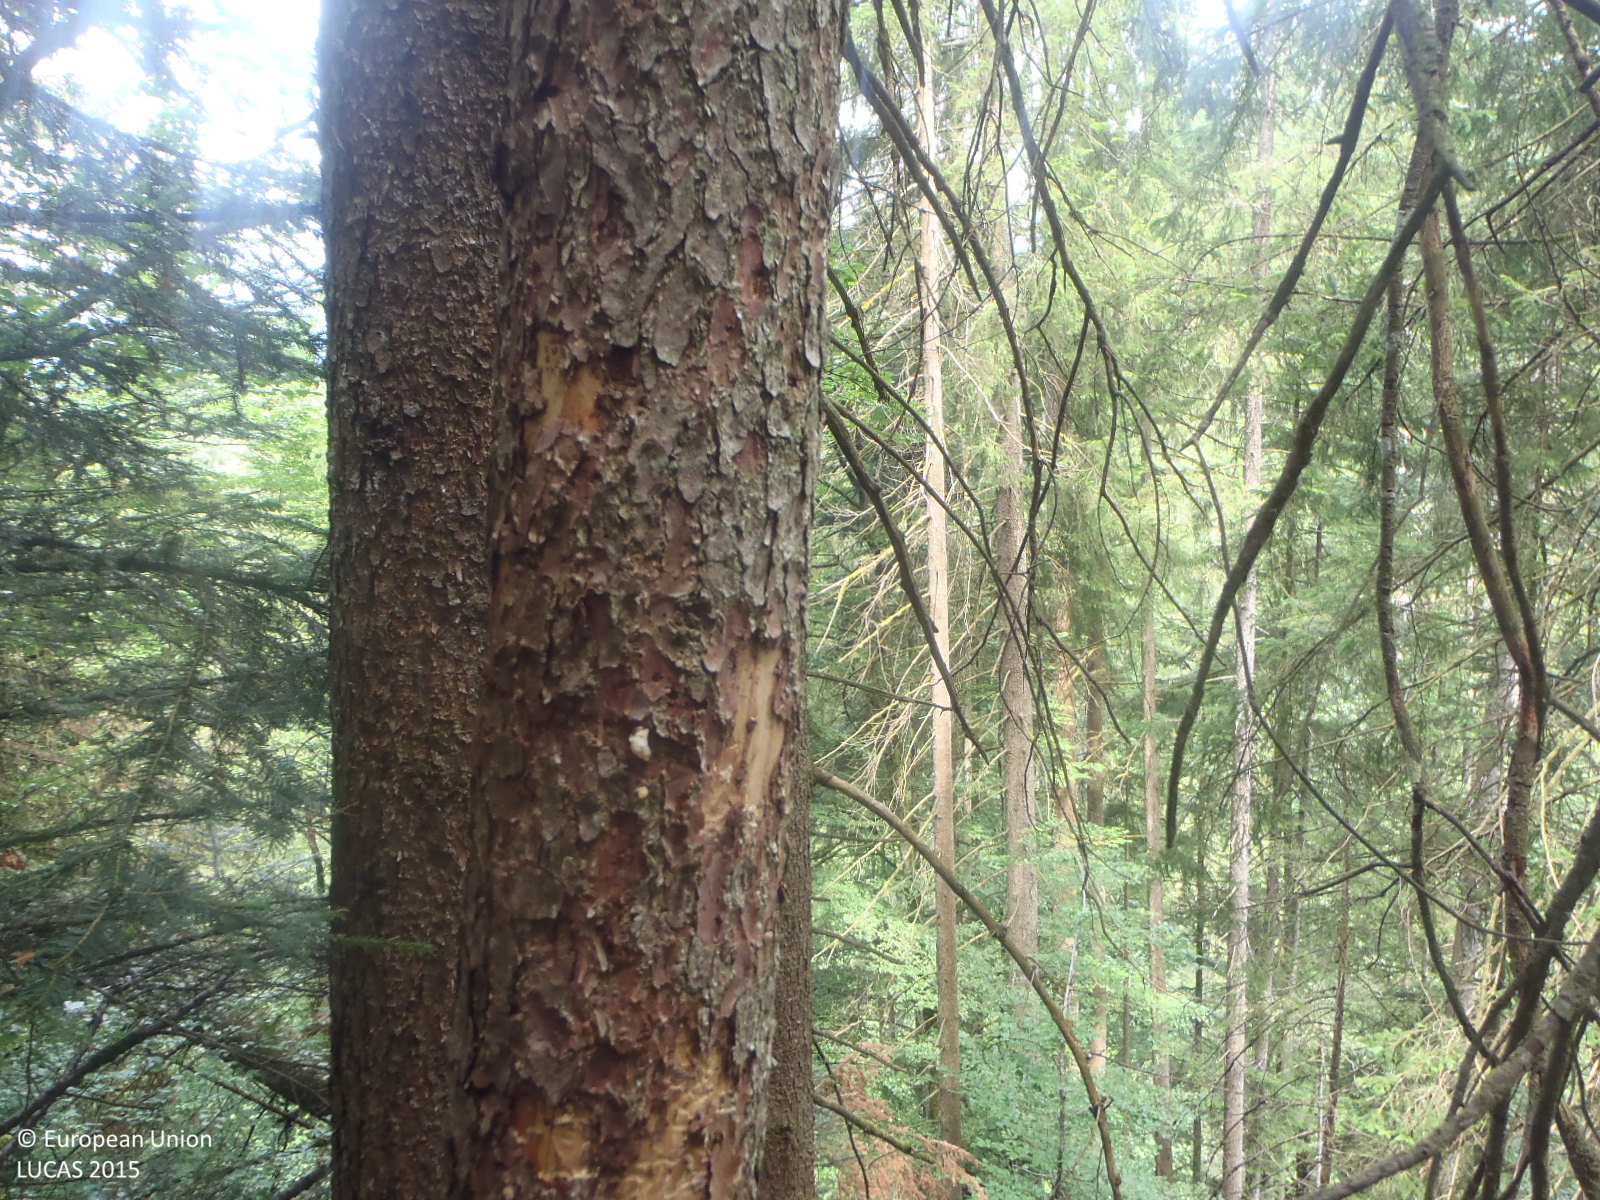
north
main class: Woodland
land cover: Spruce dominated mixed woodland
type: alpine coniferous forest
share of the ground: > 75 %
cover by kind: coniferous forest trees 60 %, broadleaved forest trees 25 %, shrubs 10 %, lichens and mosses 5 %
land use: Forestry
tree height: > 5 m
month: July
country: AT
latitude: 47.4092
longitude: 12.2115
